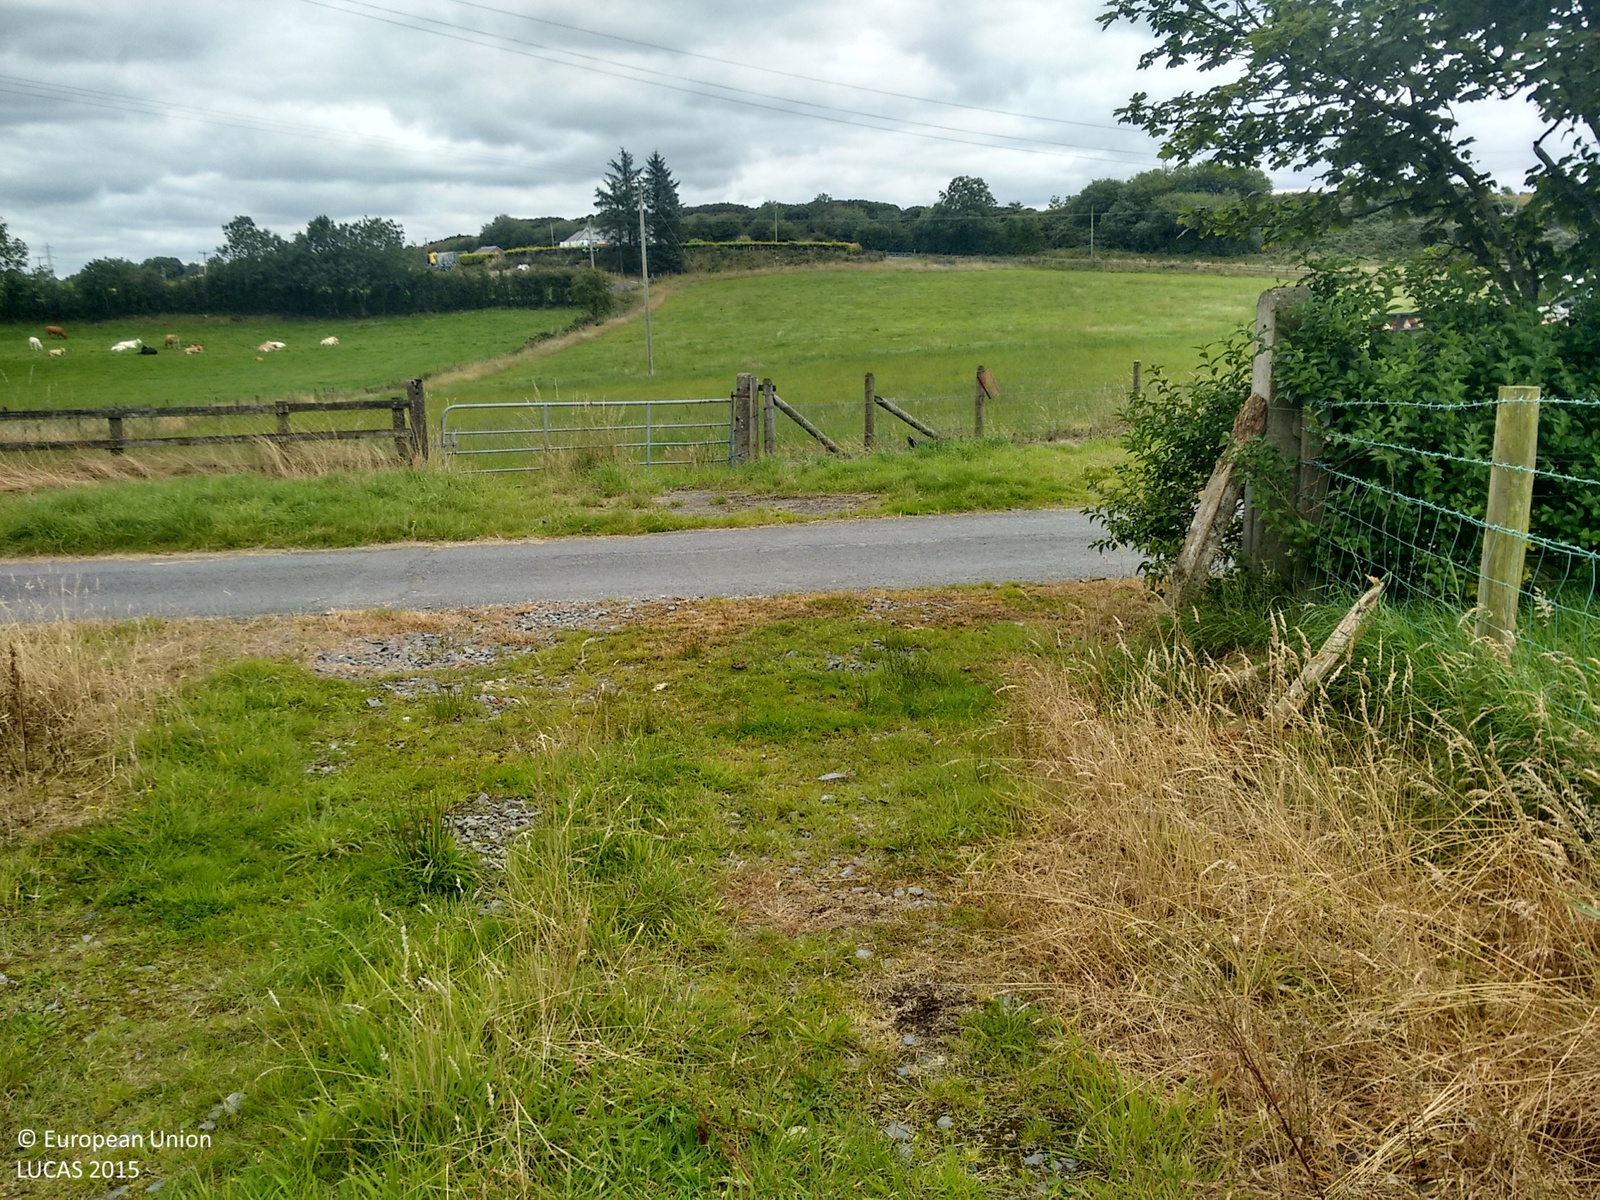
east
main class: Grassland
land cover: Grassland without tree/shrub cover
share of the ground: > 75 %
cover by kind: herbaceous plants 100 %
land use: Agriculture (excluding fallow land and kitchen gardens)
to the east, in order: Grassland without tree/shrub cover; Fences; Artificial constructions in urban areas; Conifer hedges; Grass margins; Tracks; Grass margins; Artificial constructions in urban areas; Spontaneously vegetated surfaces; Ditches and canals; Grassland without tree/shrub cover; Electric lines; Grassland without tree/shrub cover; Fences; Grass margins; Paved roads, cycling and walking lanes; Grassland without tree/shrub cover; Rock outcrops; Shrubland with sparse tree cover; Broadleaved woodland; Rocks and stones; Inland fresh water bodies
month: August
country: GB
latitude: 54.1579
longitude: -6.5901
